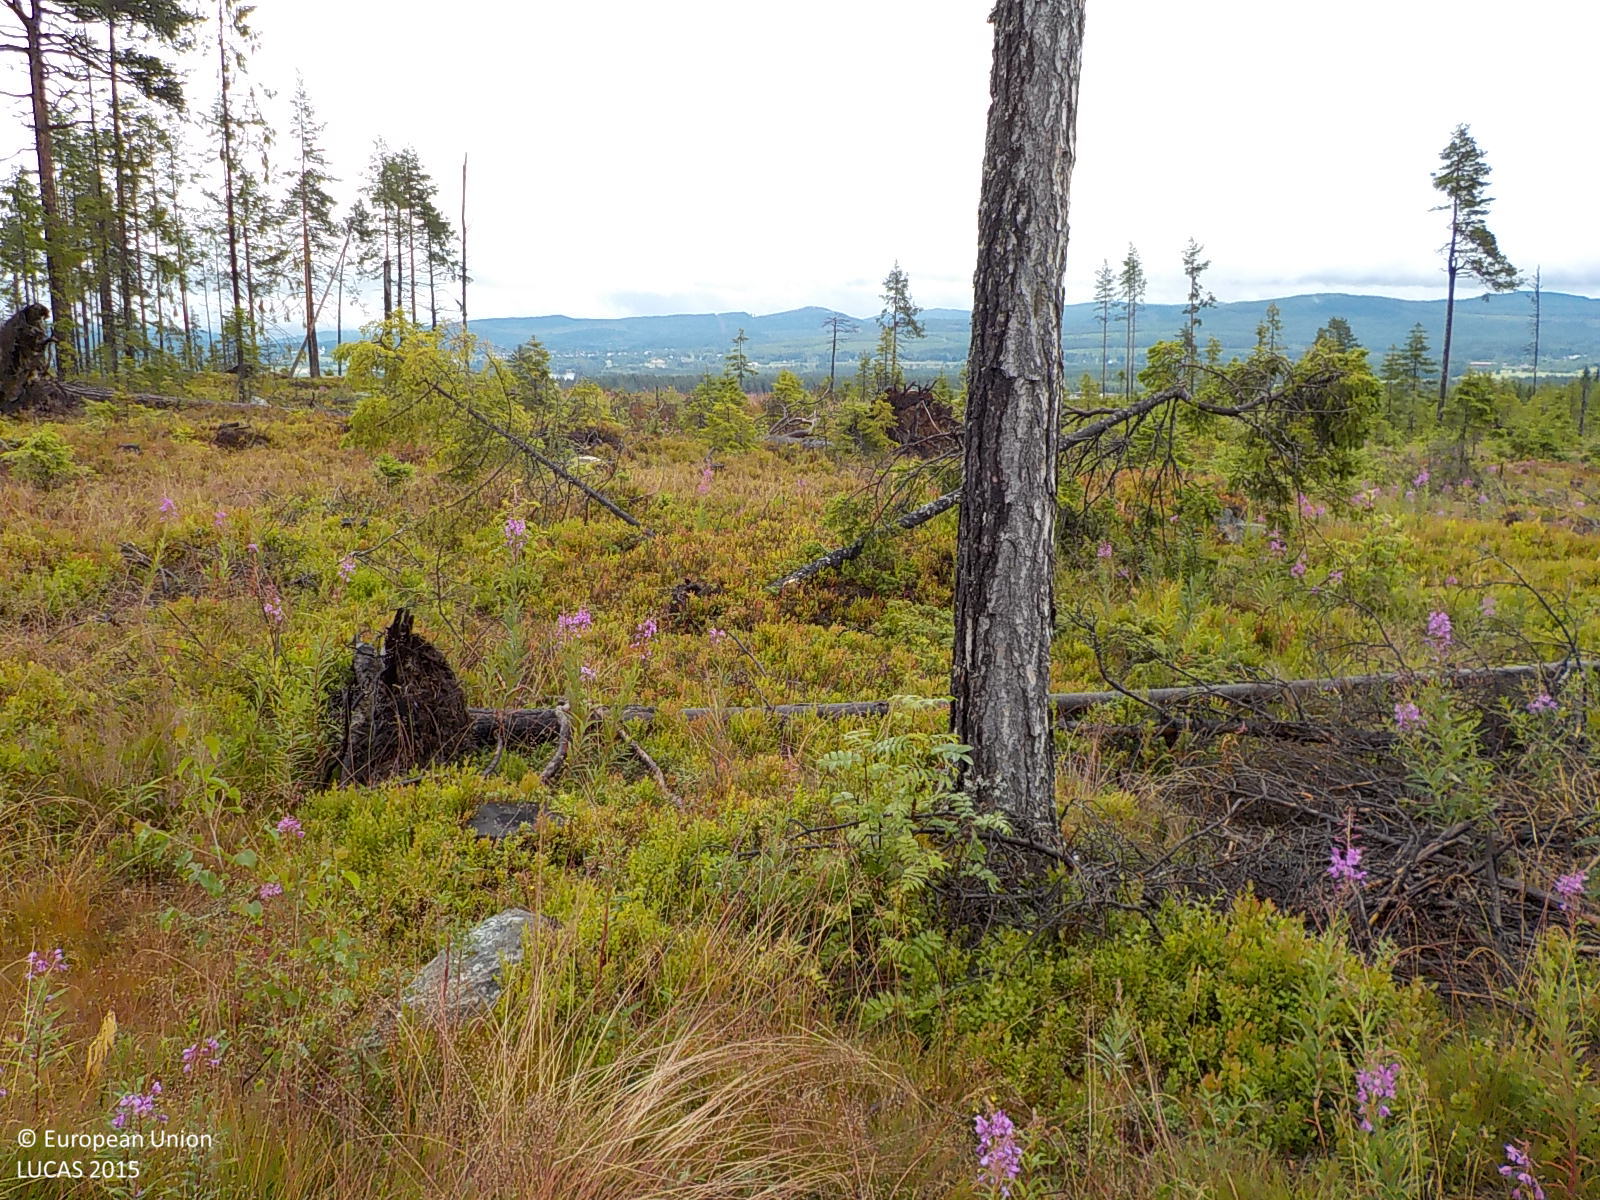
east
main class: Woodland
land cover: Other mixed woodland
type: boreal forest
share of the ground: 50 - 75 %
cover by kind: shrubs 45 %, broadleaved forest trees 30 %, coniferous forest trees 25 %
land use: Forestry
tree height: < 5 m
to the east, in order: Other mixed woodland; Shrubland without tree cover; Shrubland with sparse tree cover; Spruce dominated coniferous woodland
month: July
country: SE
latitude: 63.1765
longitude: 16.9477
